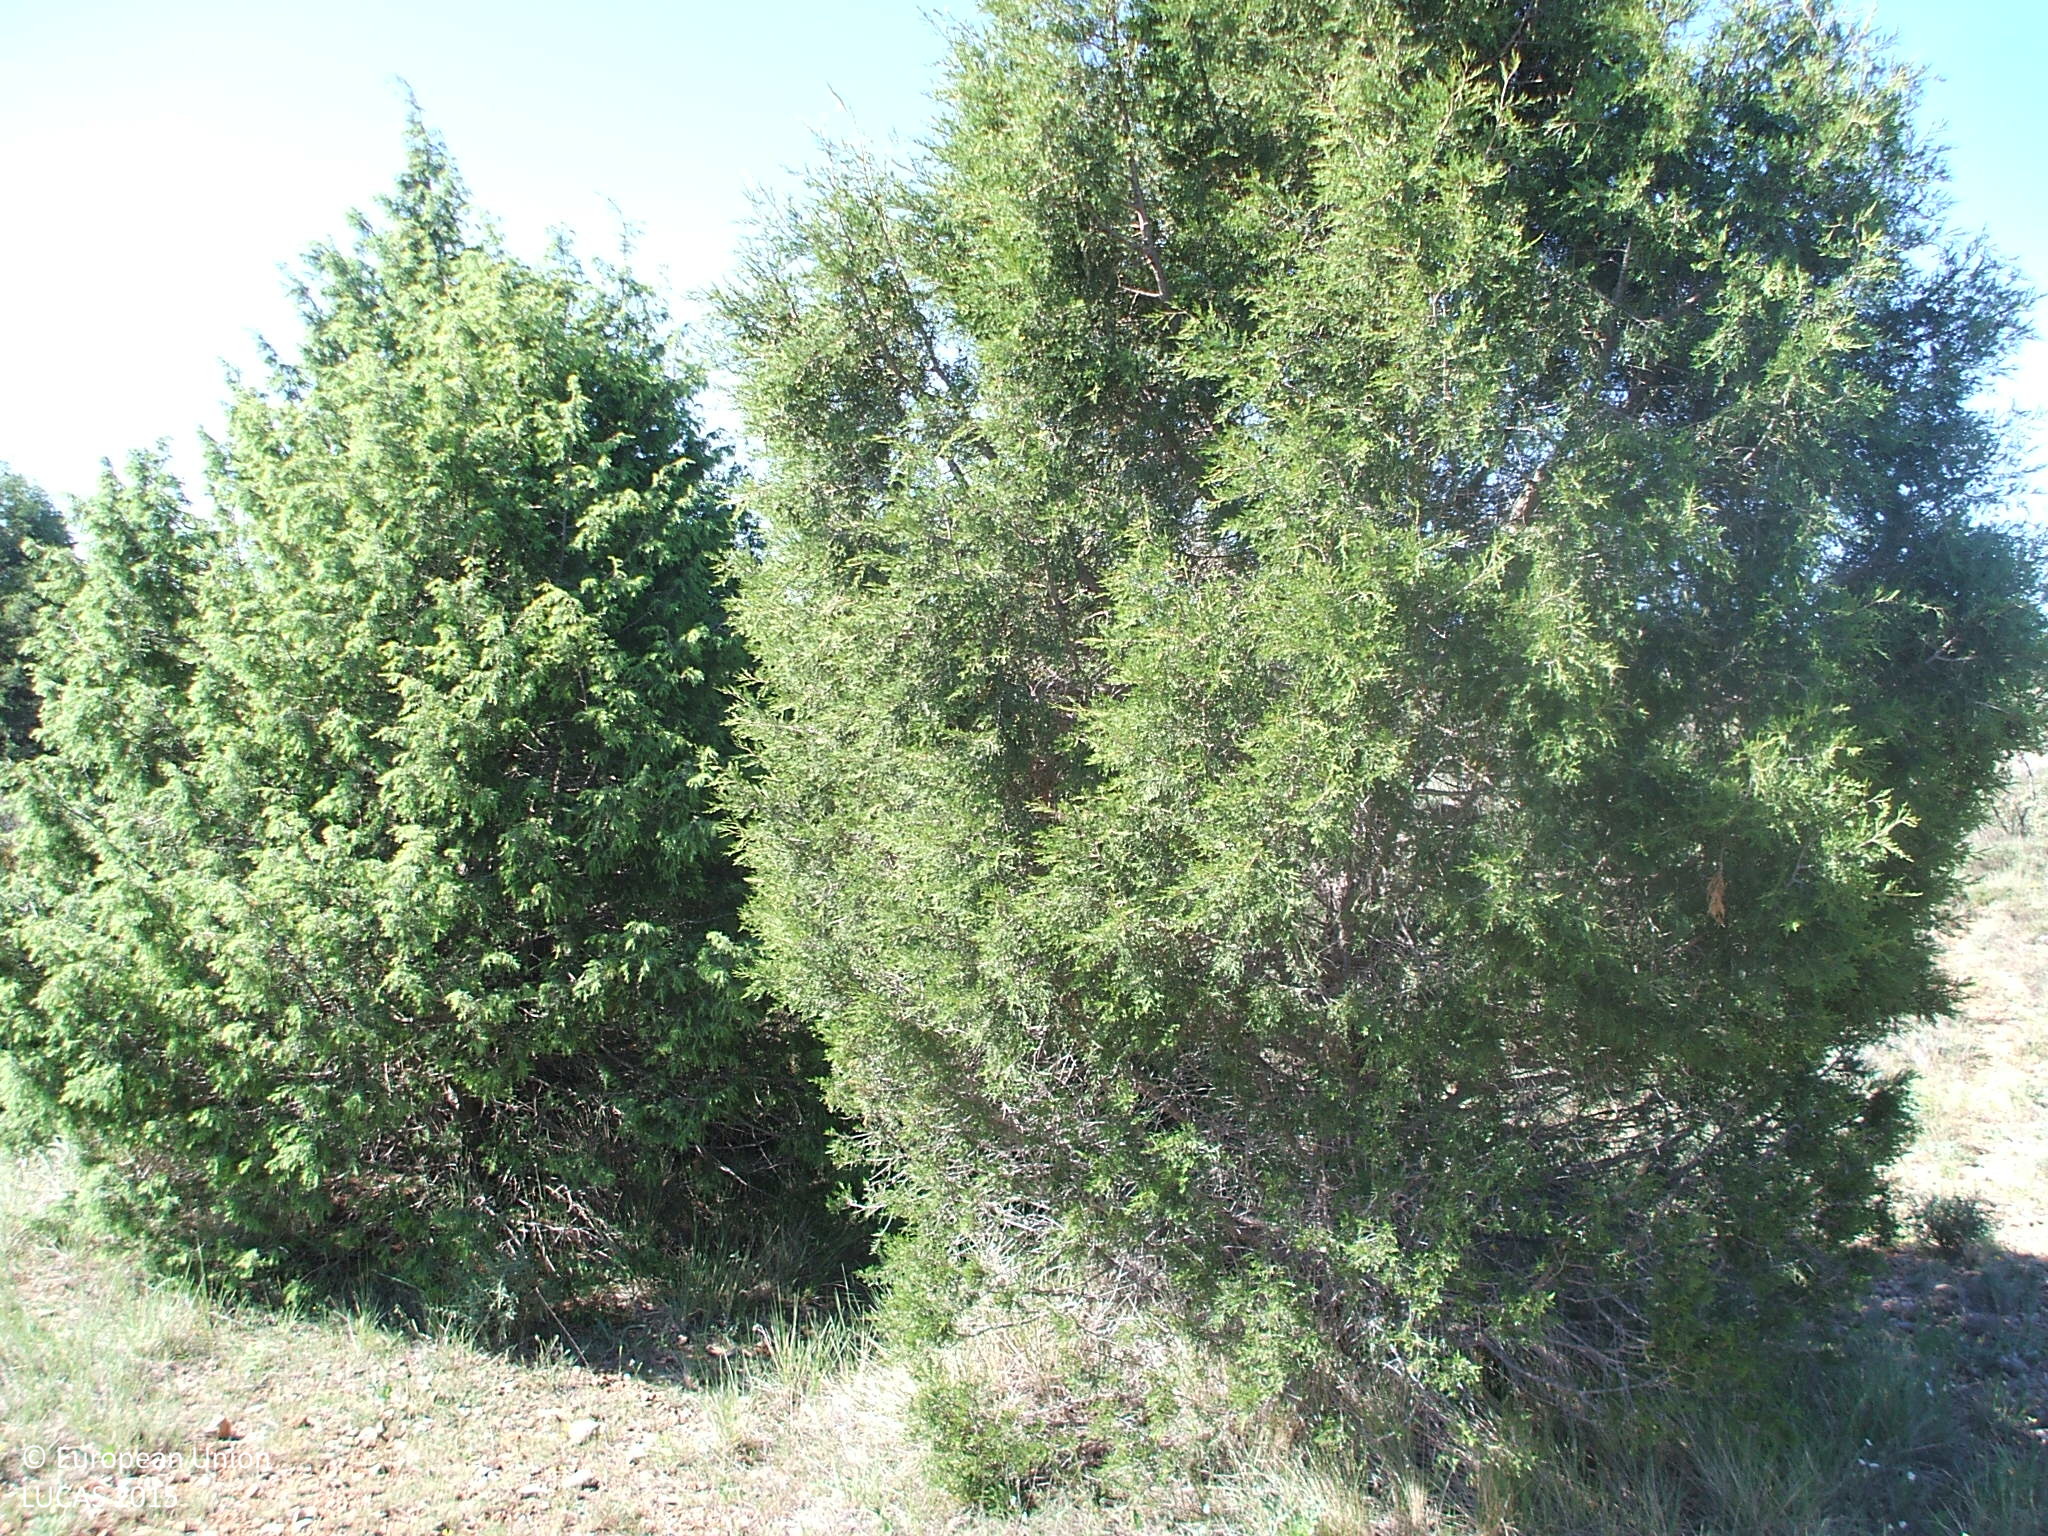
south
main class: Woodland
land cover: Other coniferous woodland
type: coniferous forest of the mediterranean region
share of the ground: 10 - 25 %
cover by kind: shrubs 45 %, unconsolidated bare surface 25 %, coniferous forest trees 20 %, herbaceous plants 10 %
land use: Semi-natural and natural areas not in use
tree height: < 5 m
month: May
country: ES
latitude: 40.1084
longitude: -0.7877
